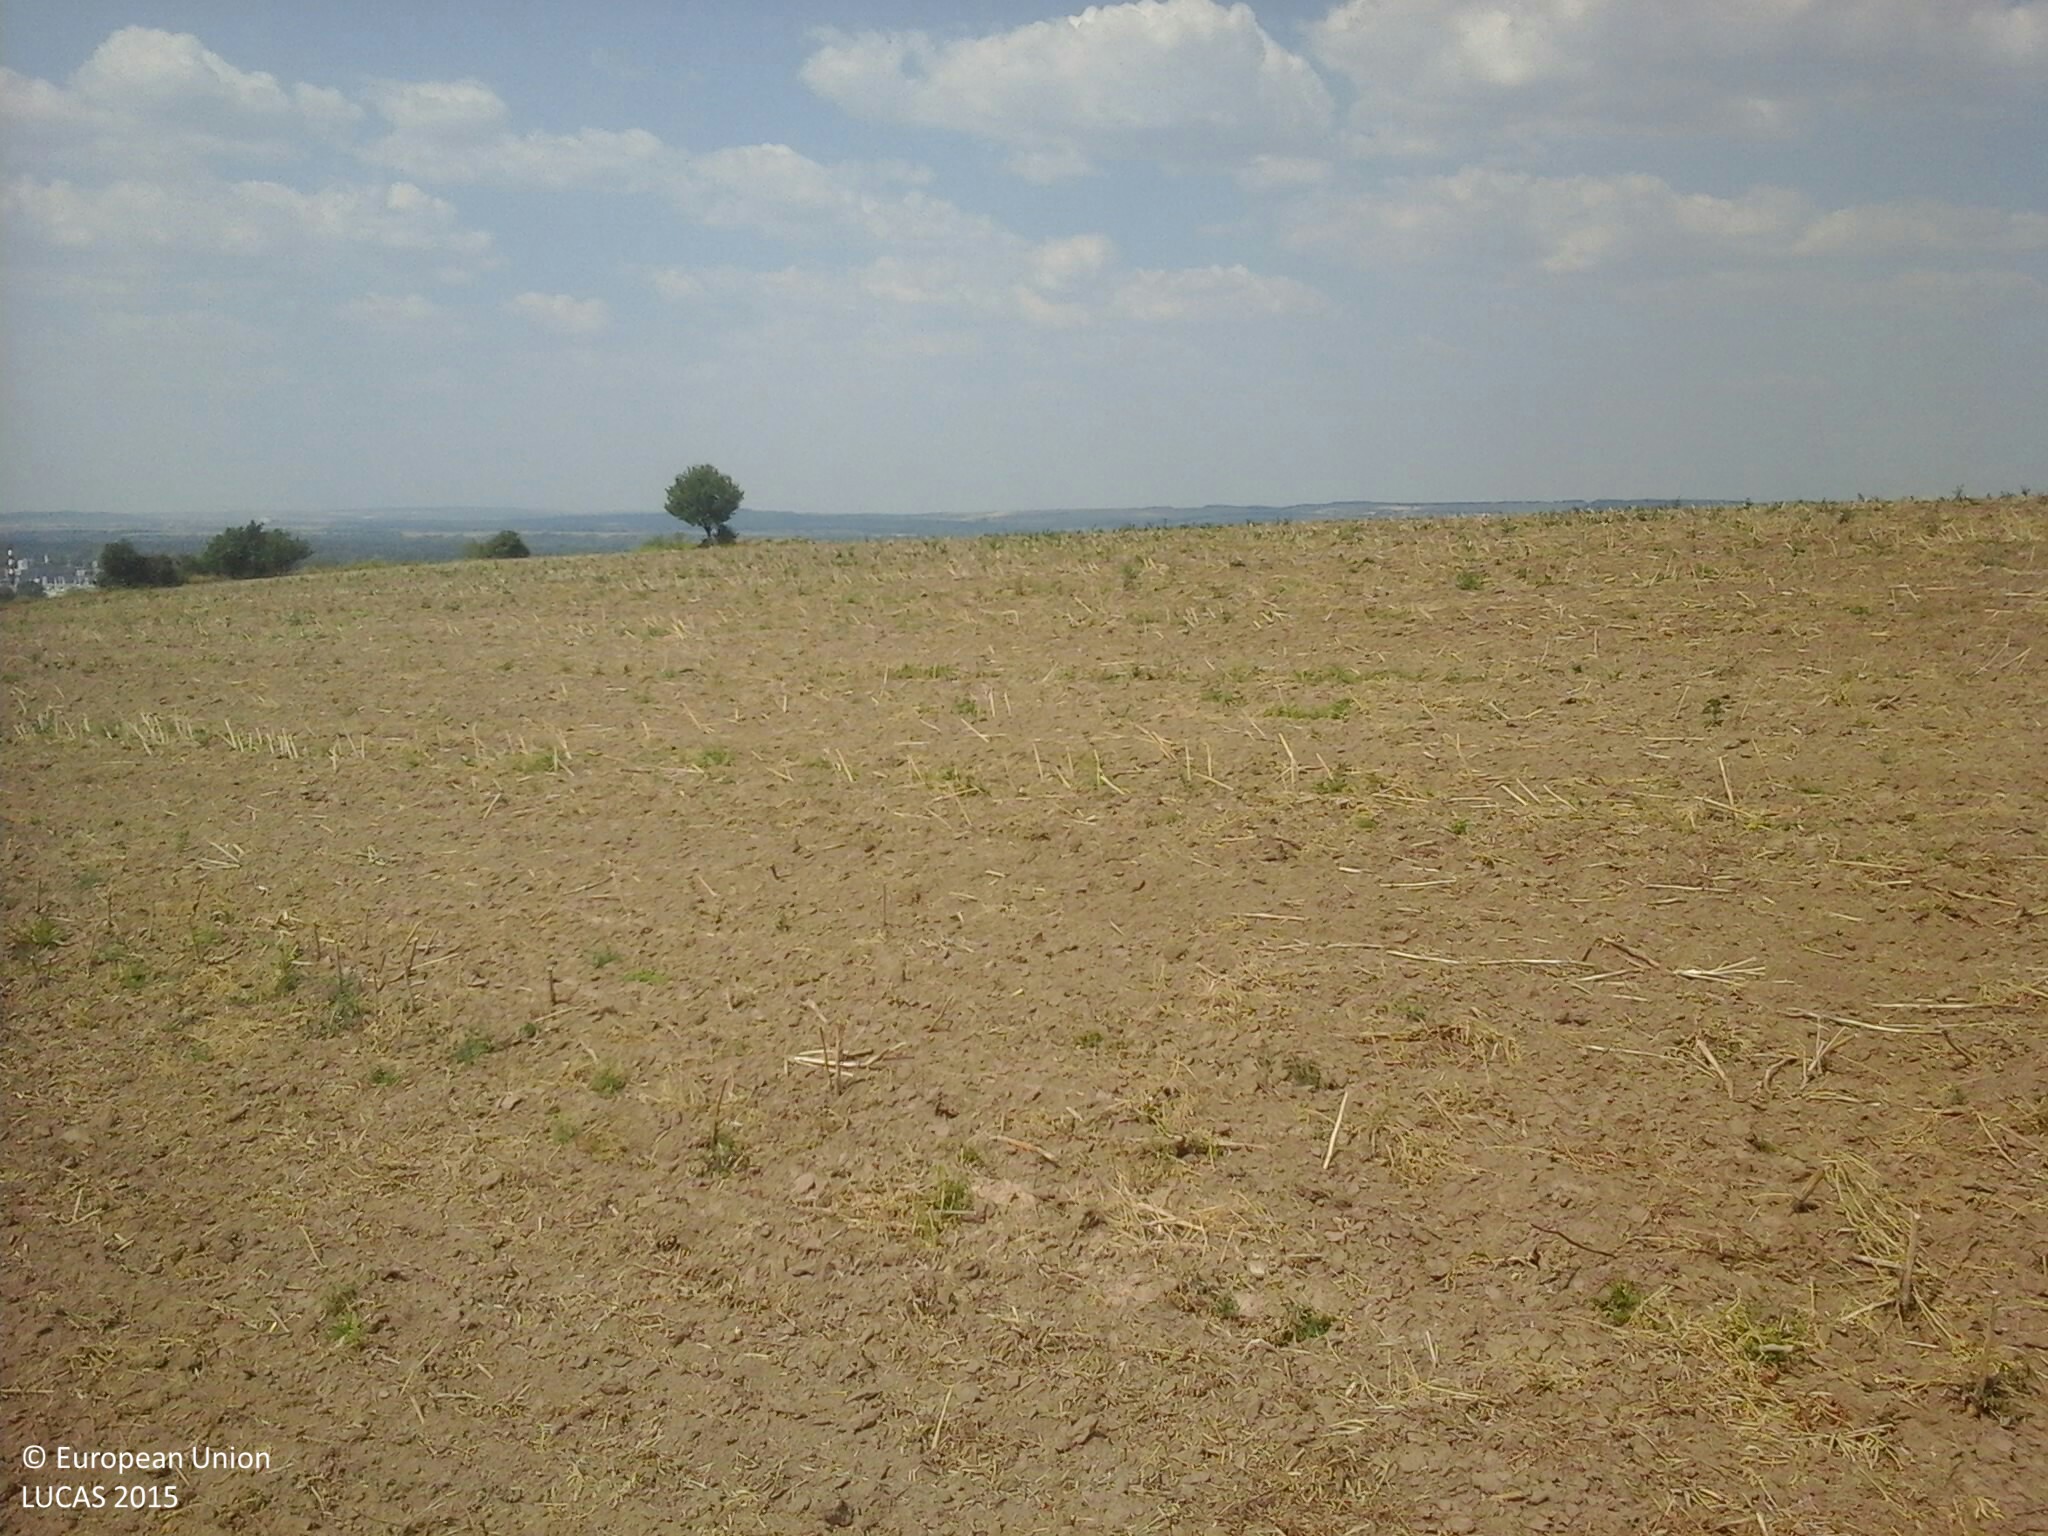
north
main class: Cropland
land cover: Rape and turnip rape
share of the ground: < 10 %
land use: Agriculture (excluding fallow land and kitchen gardens)
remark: Harvested field
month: August
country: HU
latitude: 47.7430
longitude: 18.5908
